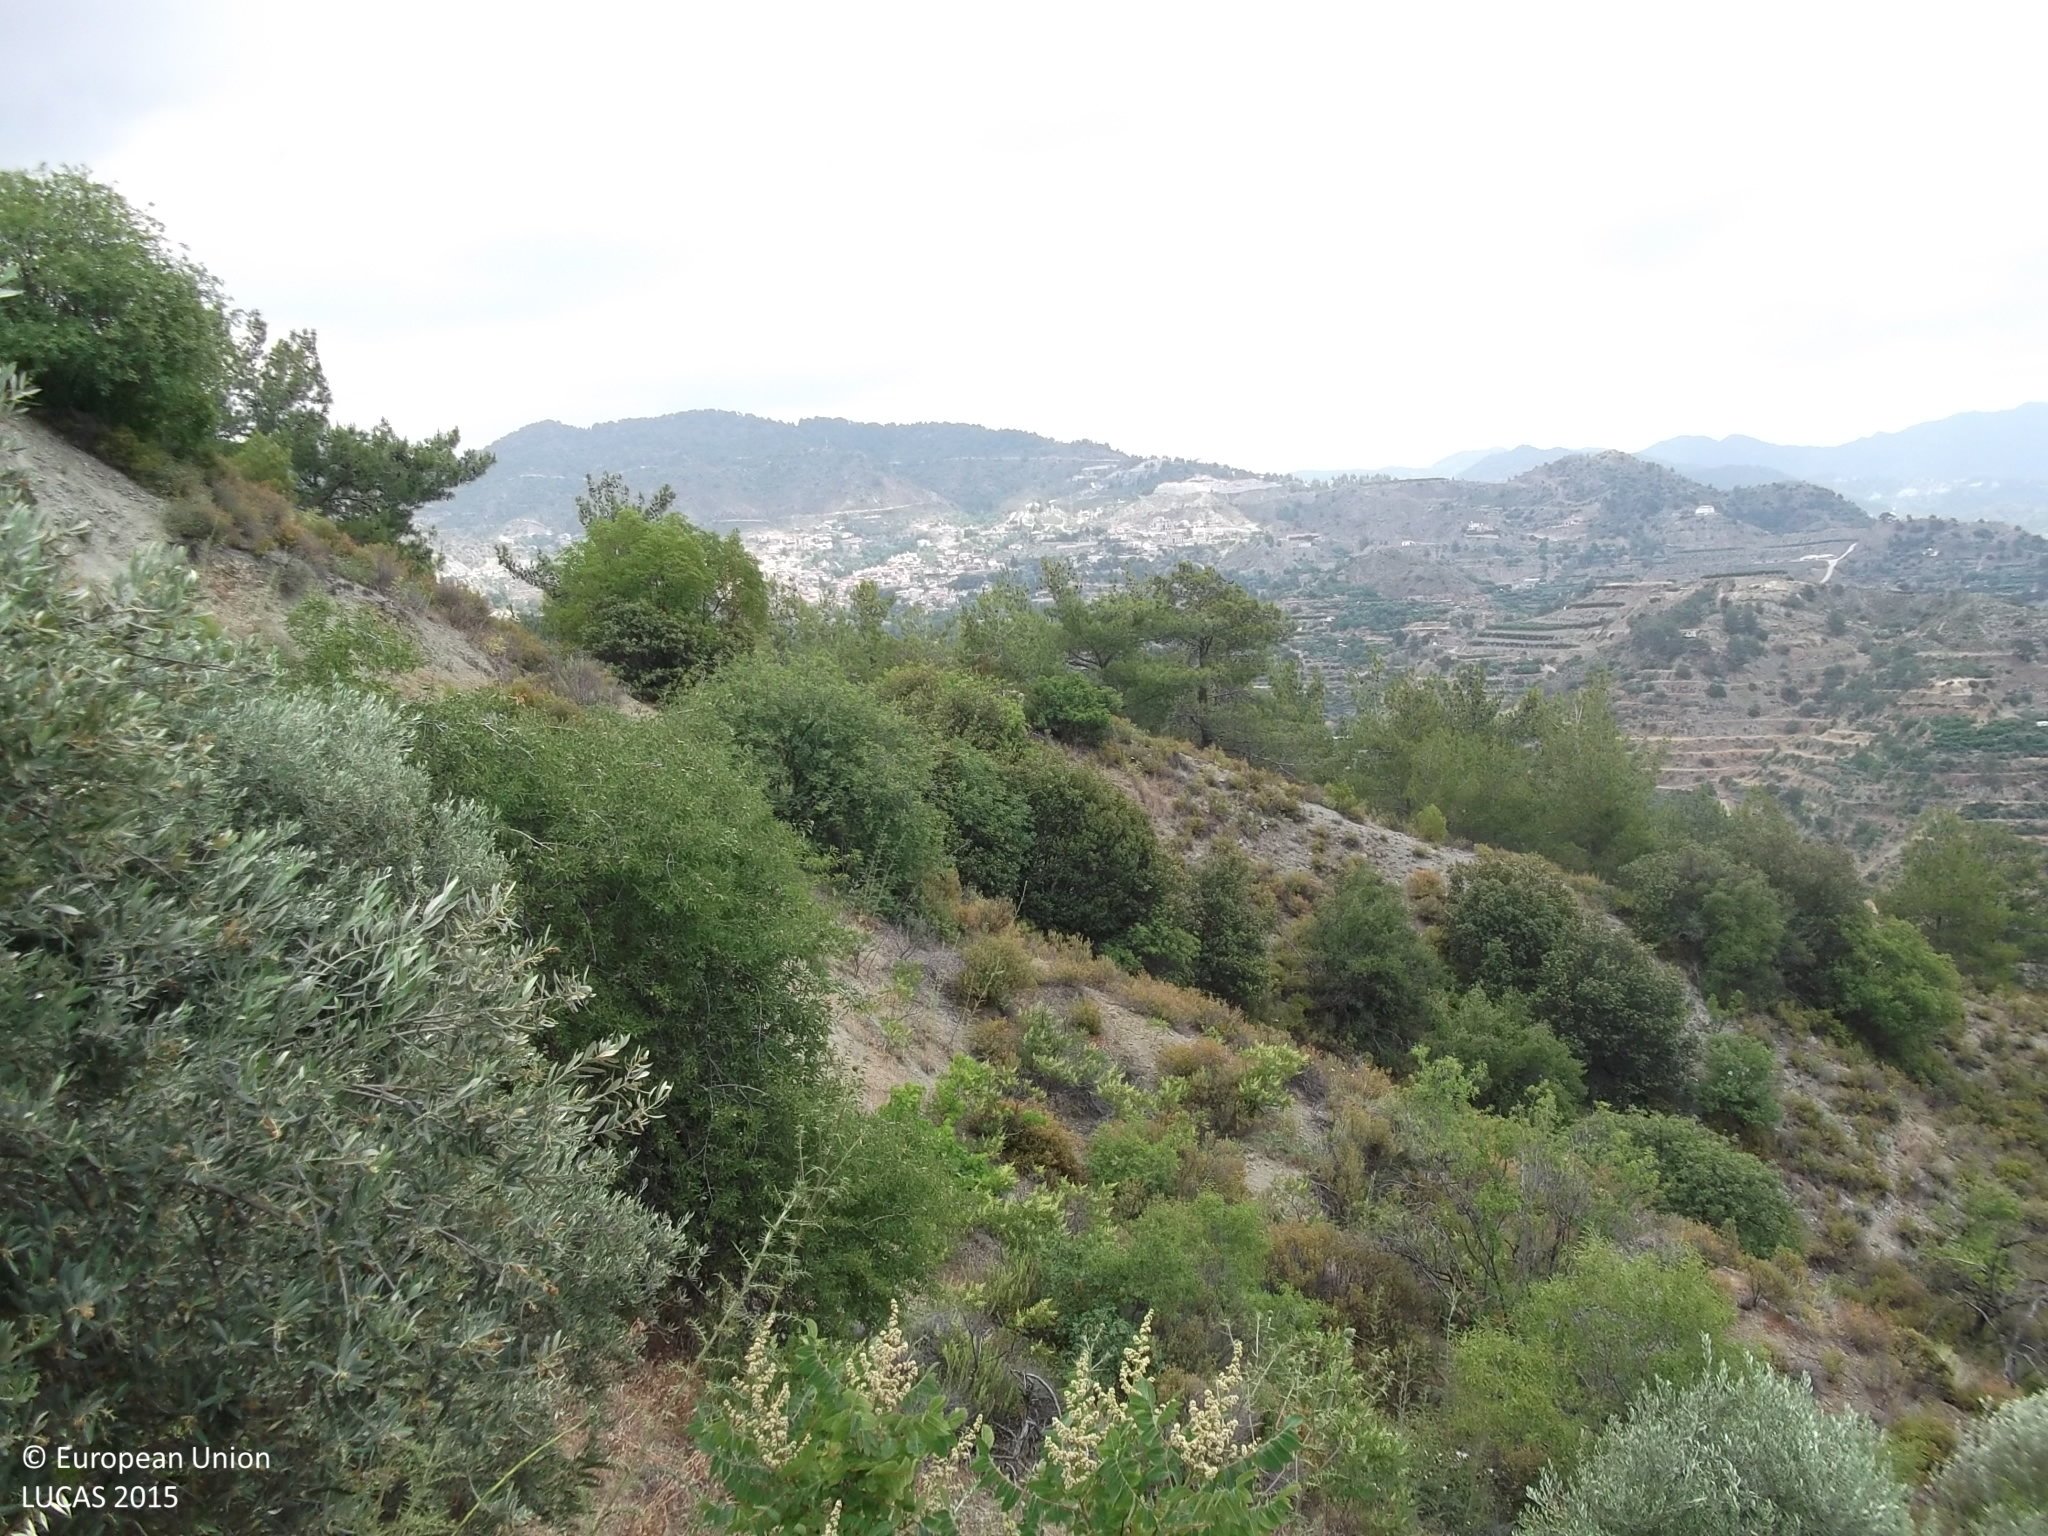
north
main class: Woodland
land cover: Pine dominated mixed woodland
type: coniferous forest of the mediterranean region
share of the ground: 25 - 50 %
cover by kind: coniferous forest trees 45 %, shrubs 25 %, broadleaved forest trees 15 %, consolidated bare surface 15 %
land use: Forestry
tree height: > 5 m
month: June
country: CY
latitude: 34.8798
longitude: 32.9578
